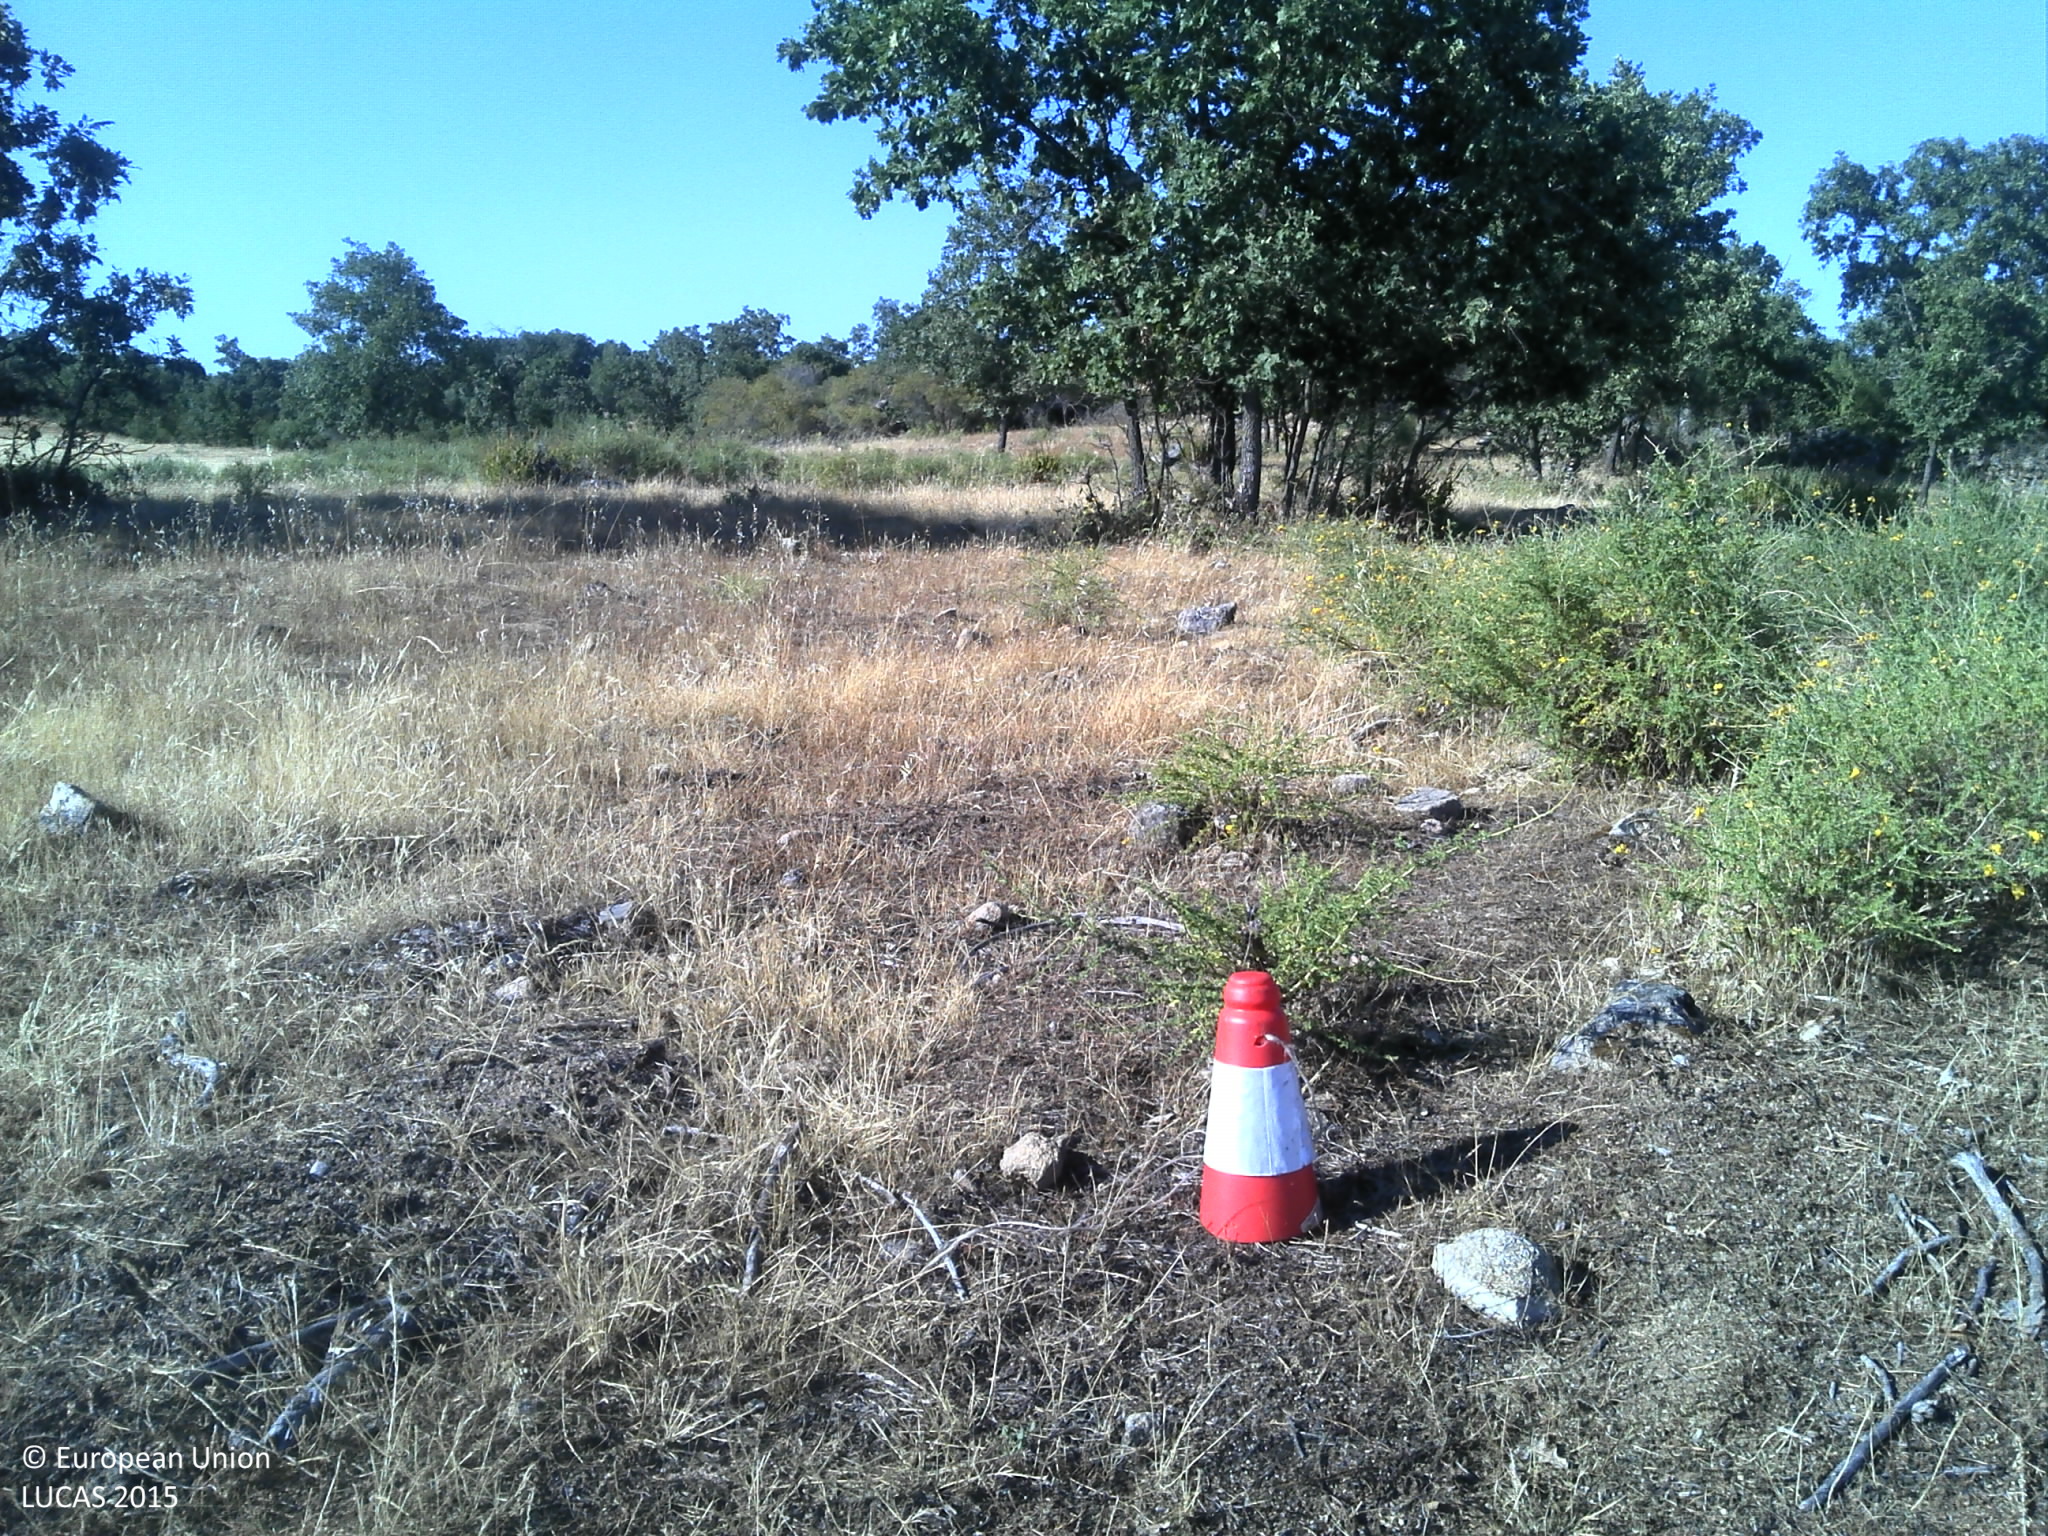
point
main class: Grassland
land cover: Grassland with sparse tree/shrub cover
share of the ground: 25 - 50 %
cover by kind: herbaceous plants 45 %, unconsolidated bare surface 40 %, broadleaved forest trees 5 %, shrubs 5 %
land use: Agriculture (excluding fallow land and kitchen gardens)
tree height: > 5 m
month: June
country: PT
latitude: 39.9766
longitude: -7.2740
